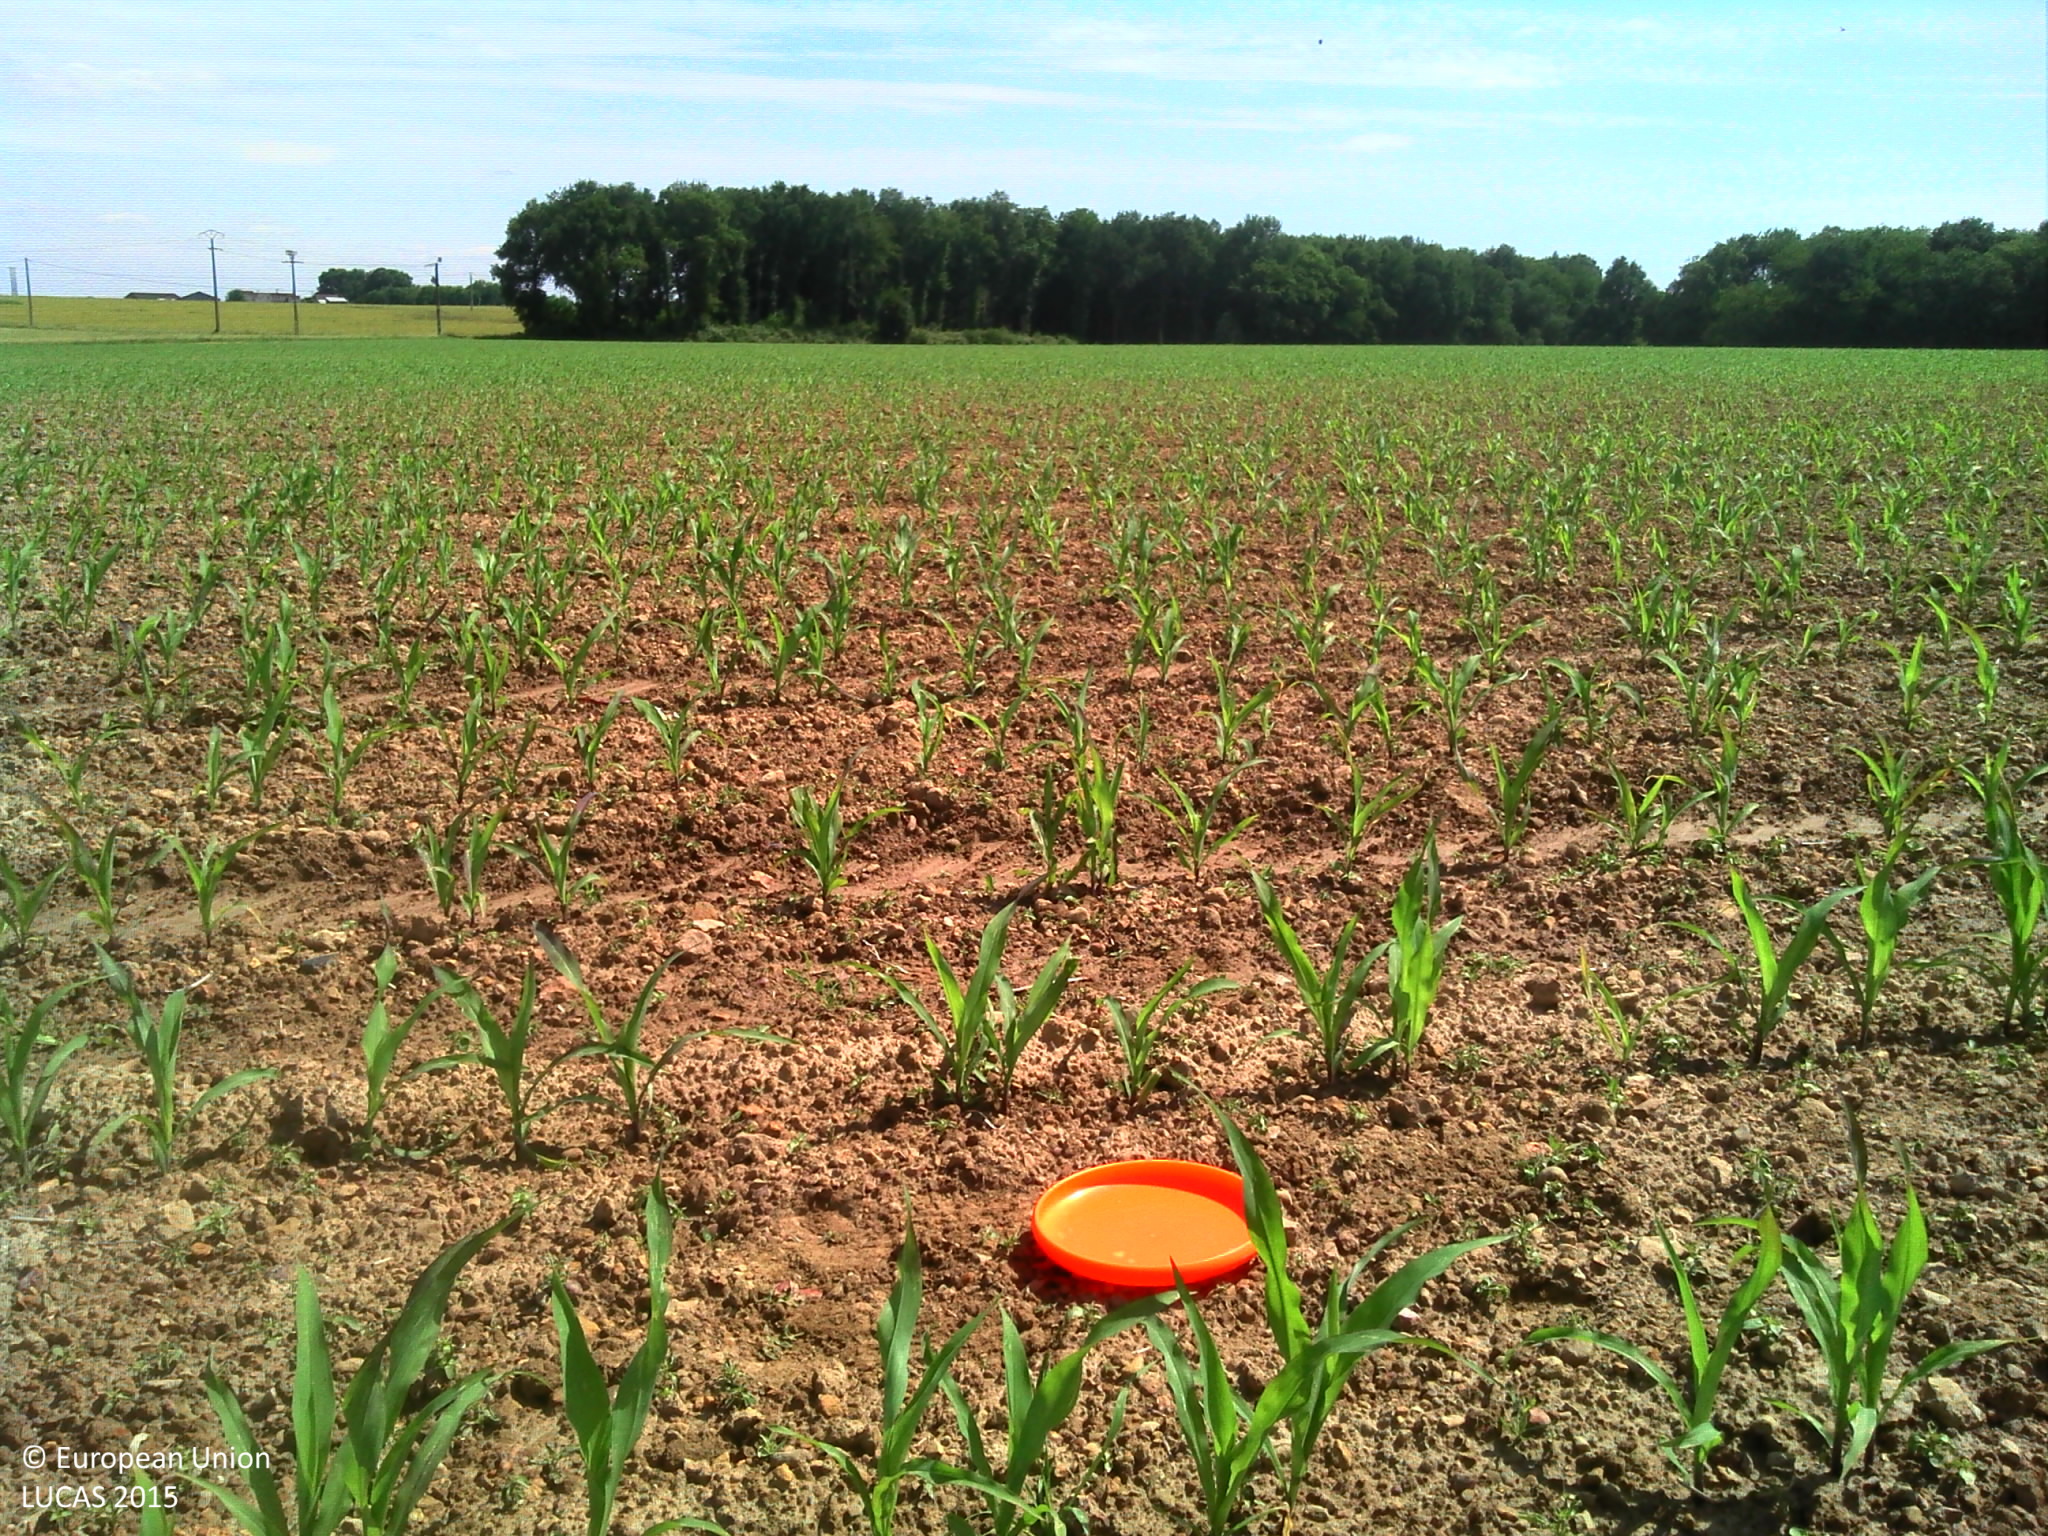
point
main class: Cropland
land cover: Maize
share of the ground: < 10 %
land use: Agriculture (excluding fallow land and kitchen gardens)
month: June
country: FR
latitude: 47.5924
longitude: 0.4695
